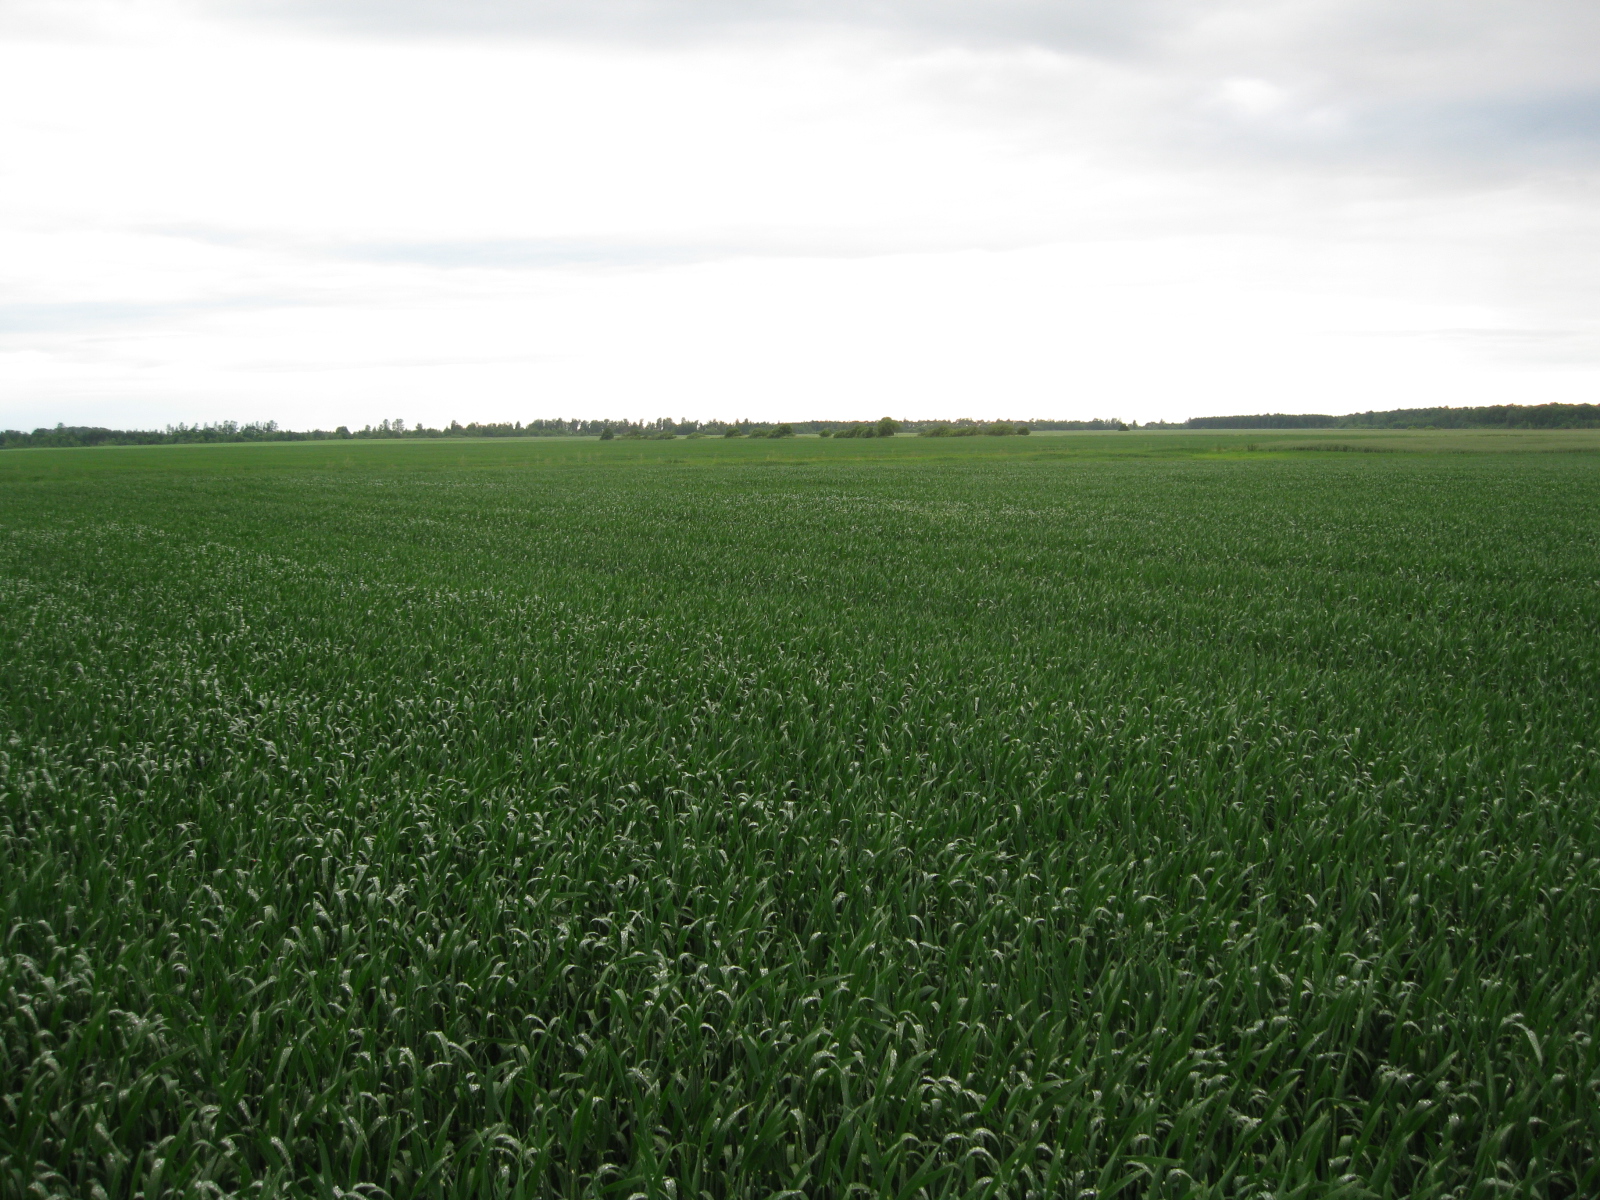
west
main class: Cropland
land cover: Common wheat
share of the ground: > 75 %
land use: Agriculture (excluding fallow land and kitchen gardens)
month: June
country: LT
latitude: 55.4492
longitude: 23.8572
